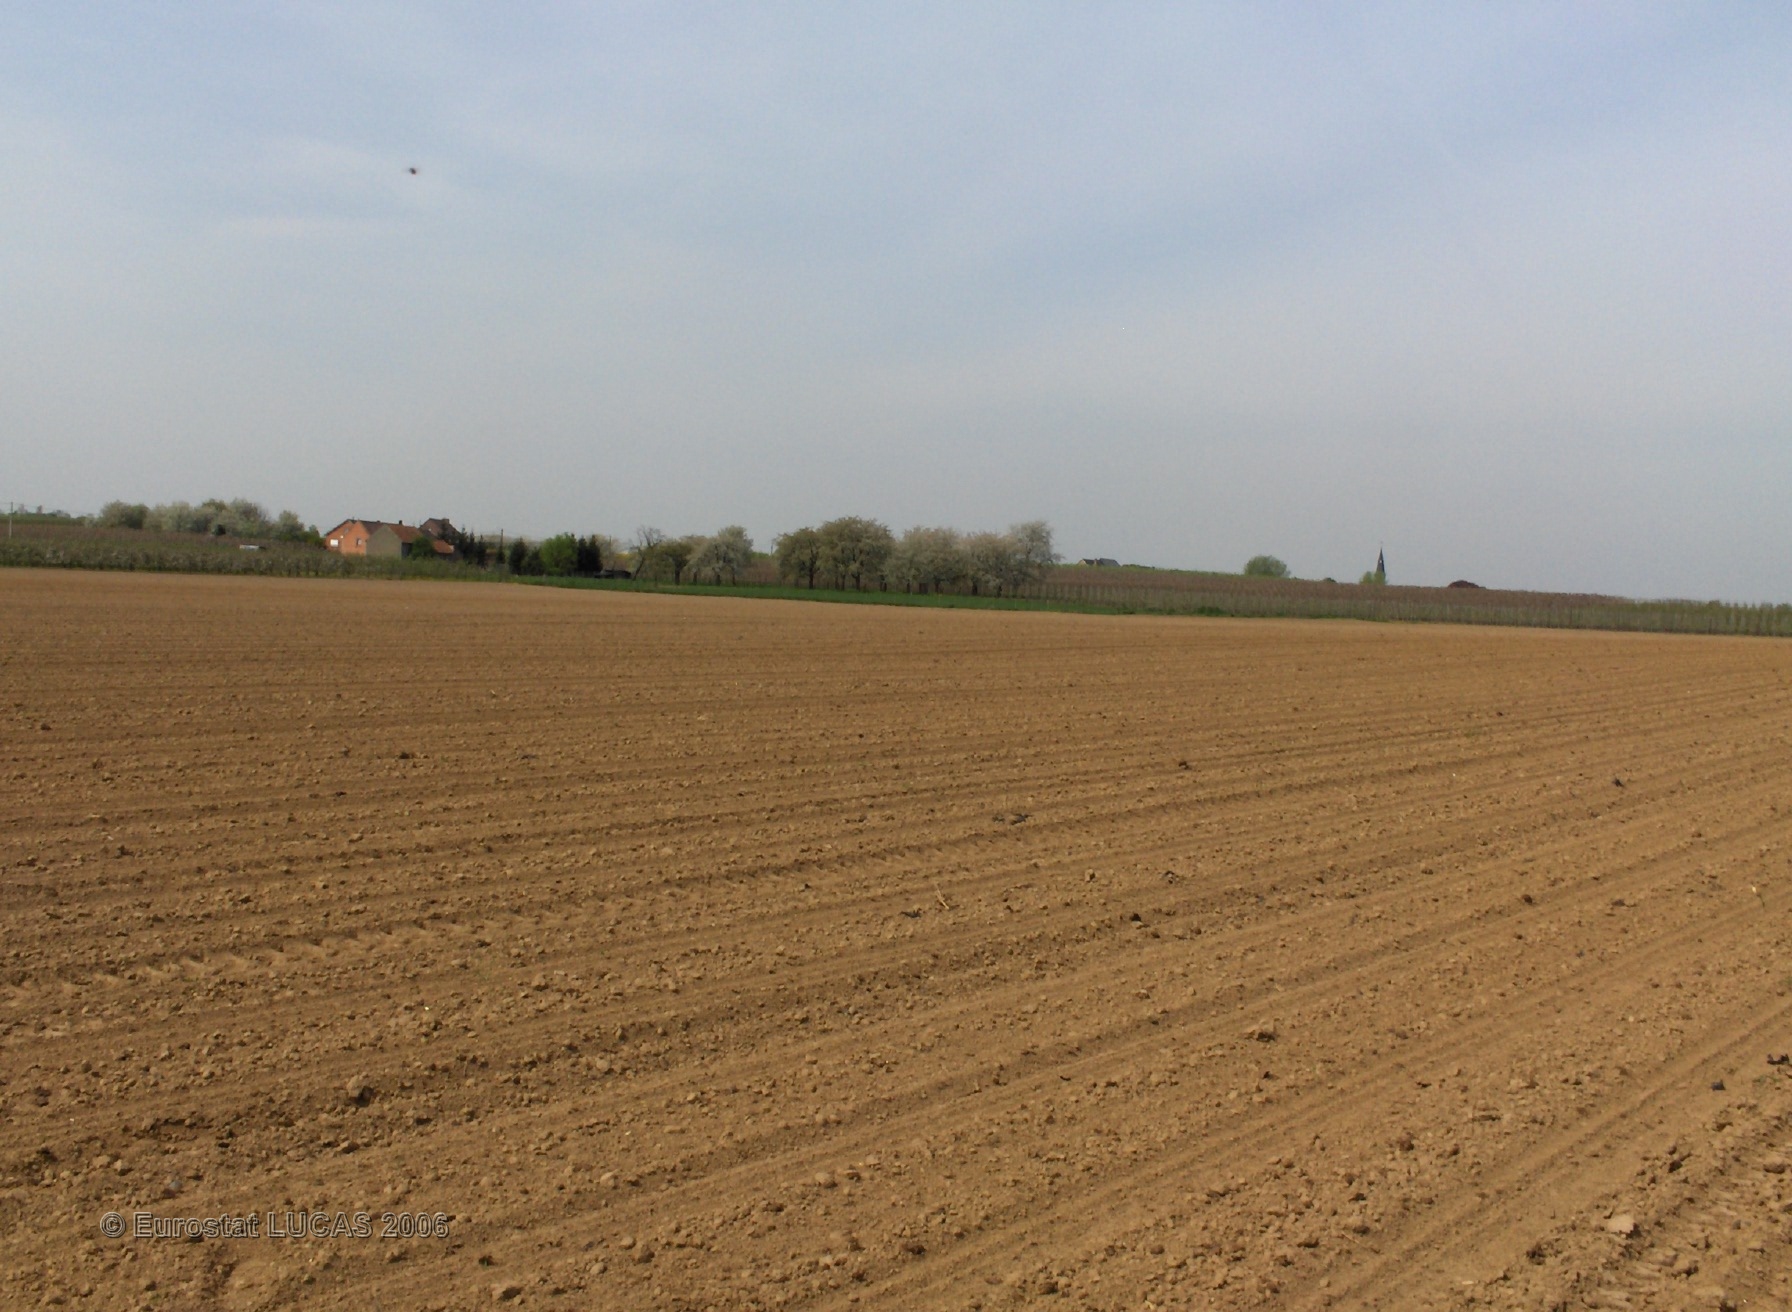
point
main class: Cropland
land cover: Maize
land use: Agriculture (excluding fallow land and kitchen gardens)
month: May
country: BE
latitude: 50.7326
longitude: 5.2229
